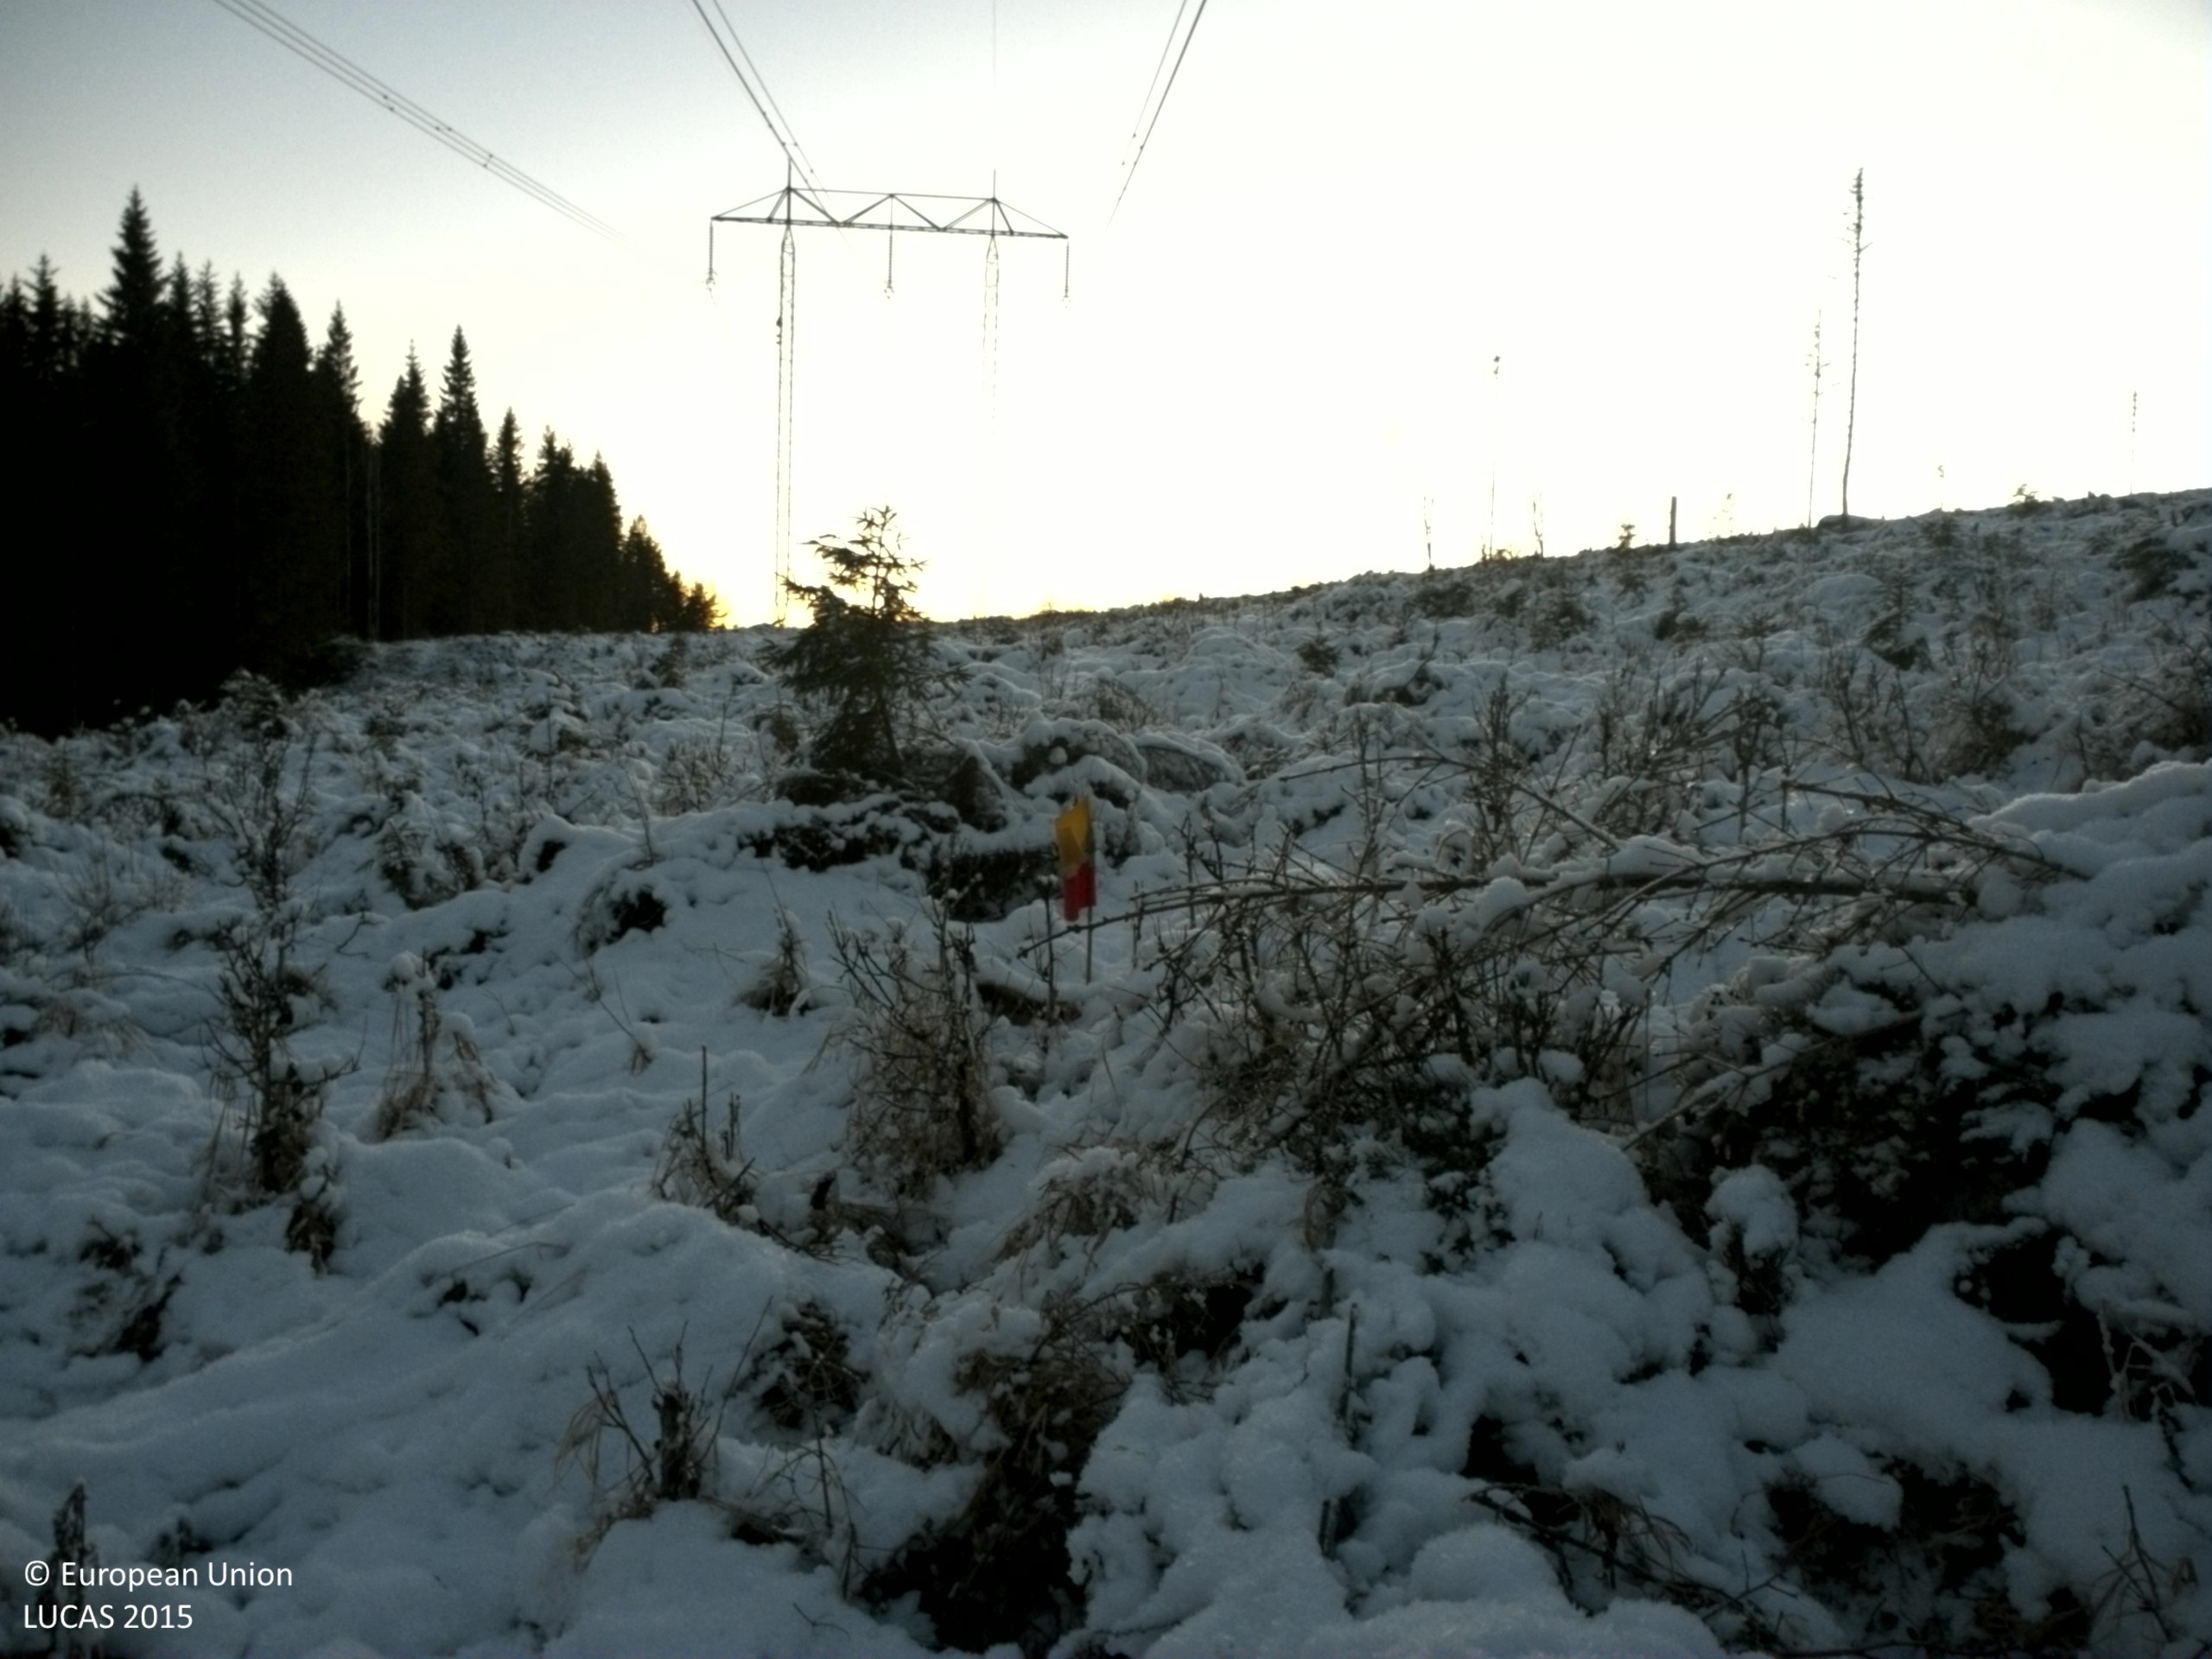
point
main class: Woodland
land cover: Spruce dominated mixed woodland
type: boreal forest
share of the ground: 10 - 25 %
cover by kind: herbaceous plants 35 %, shrubs 25 %, broadleaved forest trees 15 %, lichens and mosses 15 %, coniferous forest trees 5 %
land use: Electricity, gas and thermal power distribution
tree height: < 5 m
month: November
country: SE
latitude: 62.0417
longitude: 15.5074
